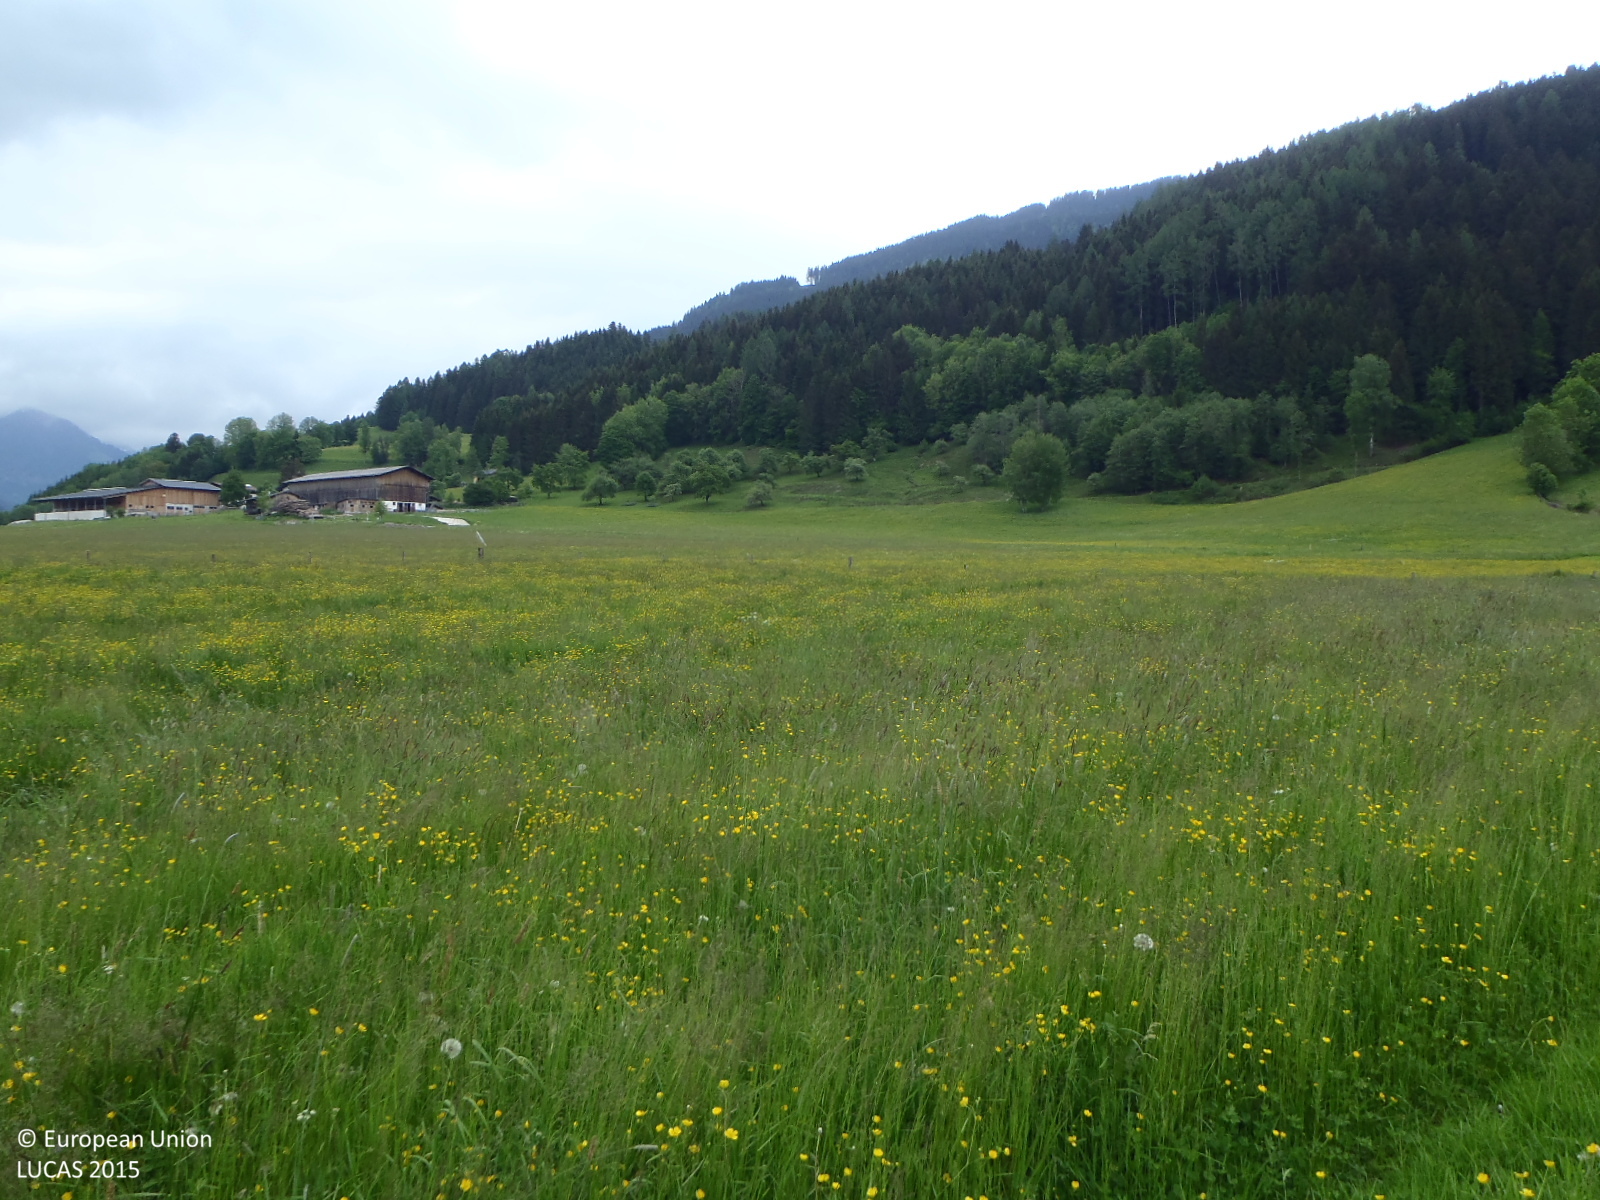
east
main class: Grassland
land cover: Grassland without tree/shrub cover
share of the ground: > 75 %
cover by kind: herbaceous plants 100 %
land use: Agriculture (excluding fallow land and kitchen gardens)
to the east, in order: Grassland without tree/shrub cover; Fences; Grassland without tree/shrub cover; Tracks; Grassland without tree/shrub cover; Fences; Grassland without tree/shrub cover; Paved roads, cycling and walking lanes; Grass margins; Fences; Grassland without tree/shrub cover
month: May
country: AT
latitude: 47.3944
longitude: 12.8466
